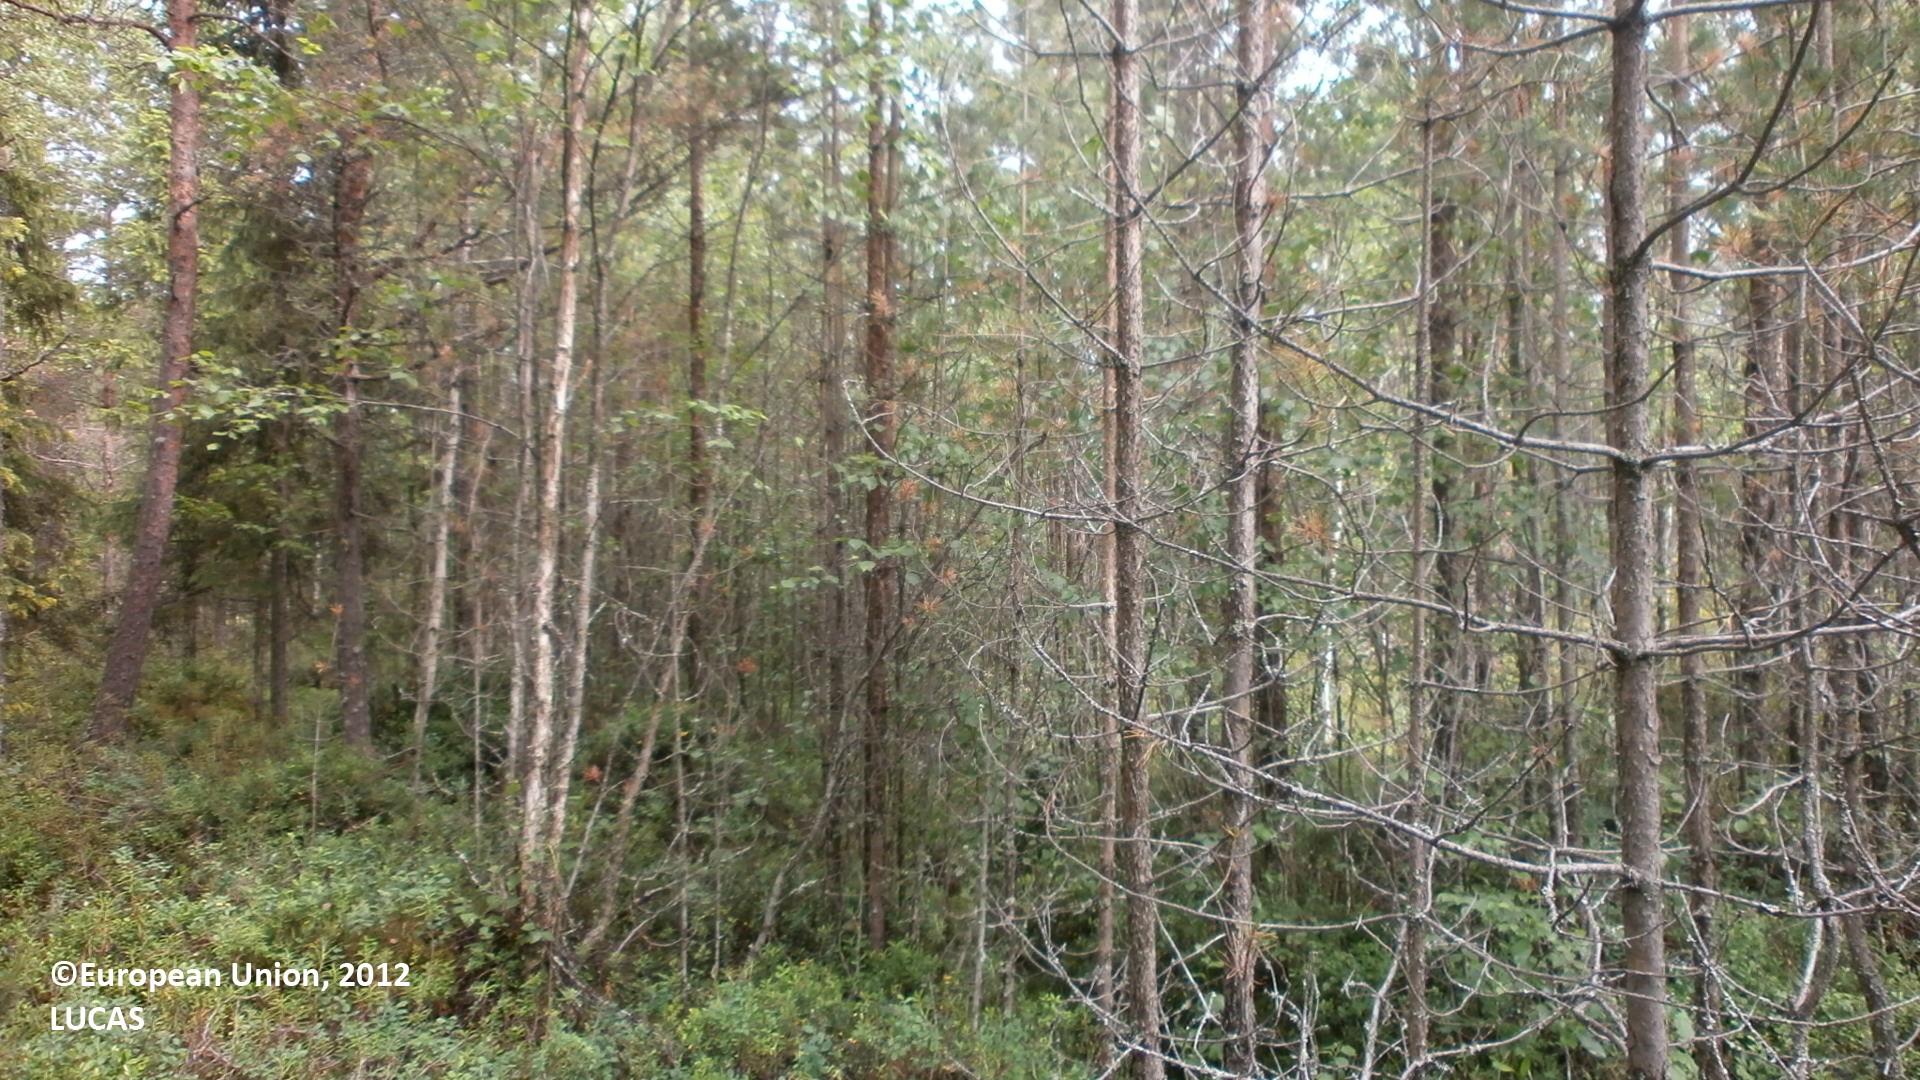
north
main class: Woodland
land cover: Pine dominated coniferous woodland
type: boreal forest
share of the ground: 50 - 75 %
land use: Forestry
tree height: > 5 m
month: July
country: FI
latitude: 64.5657
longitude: 24.4033
